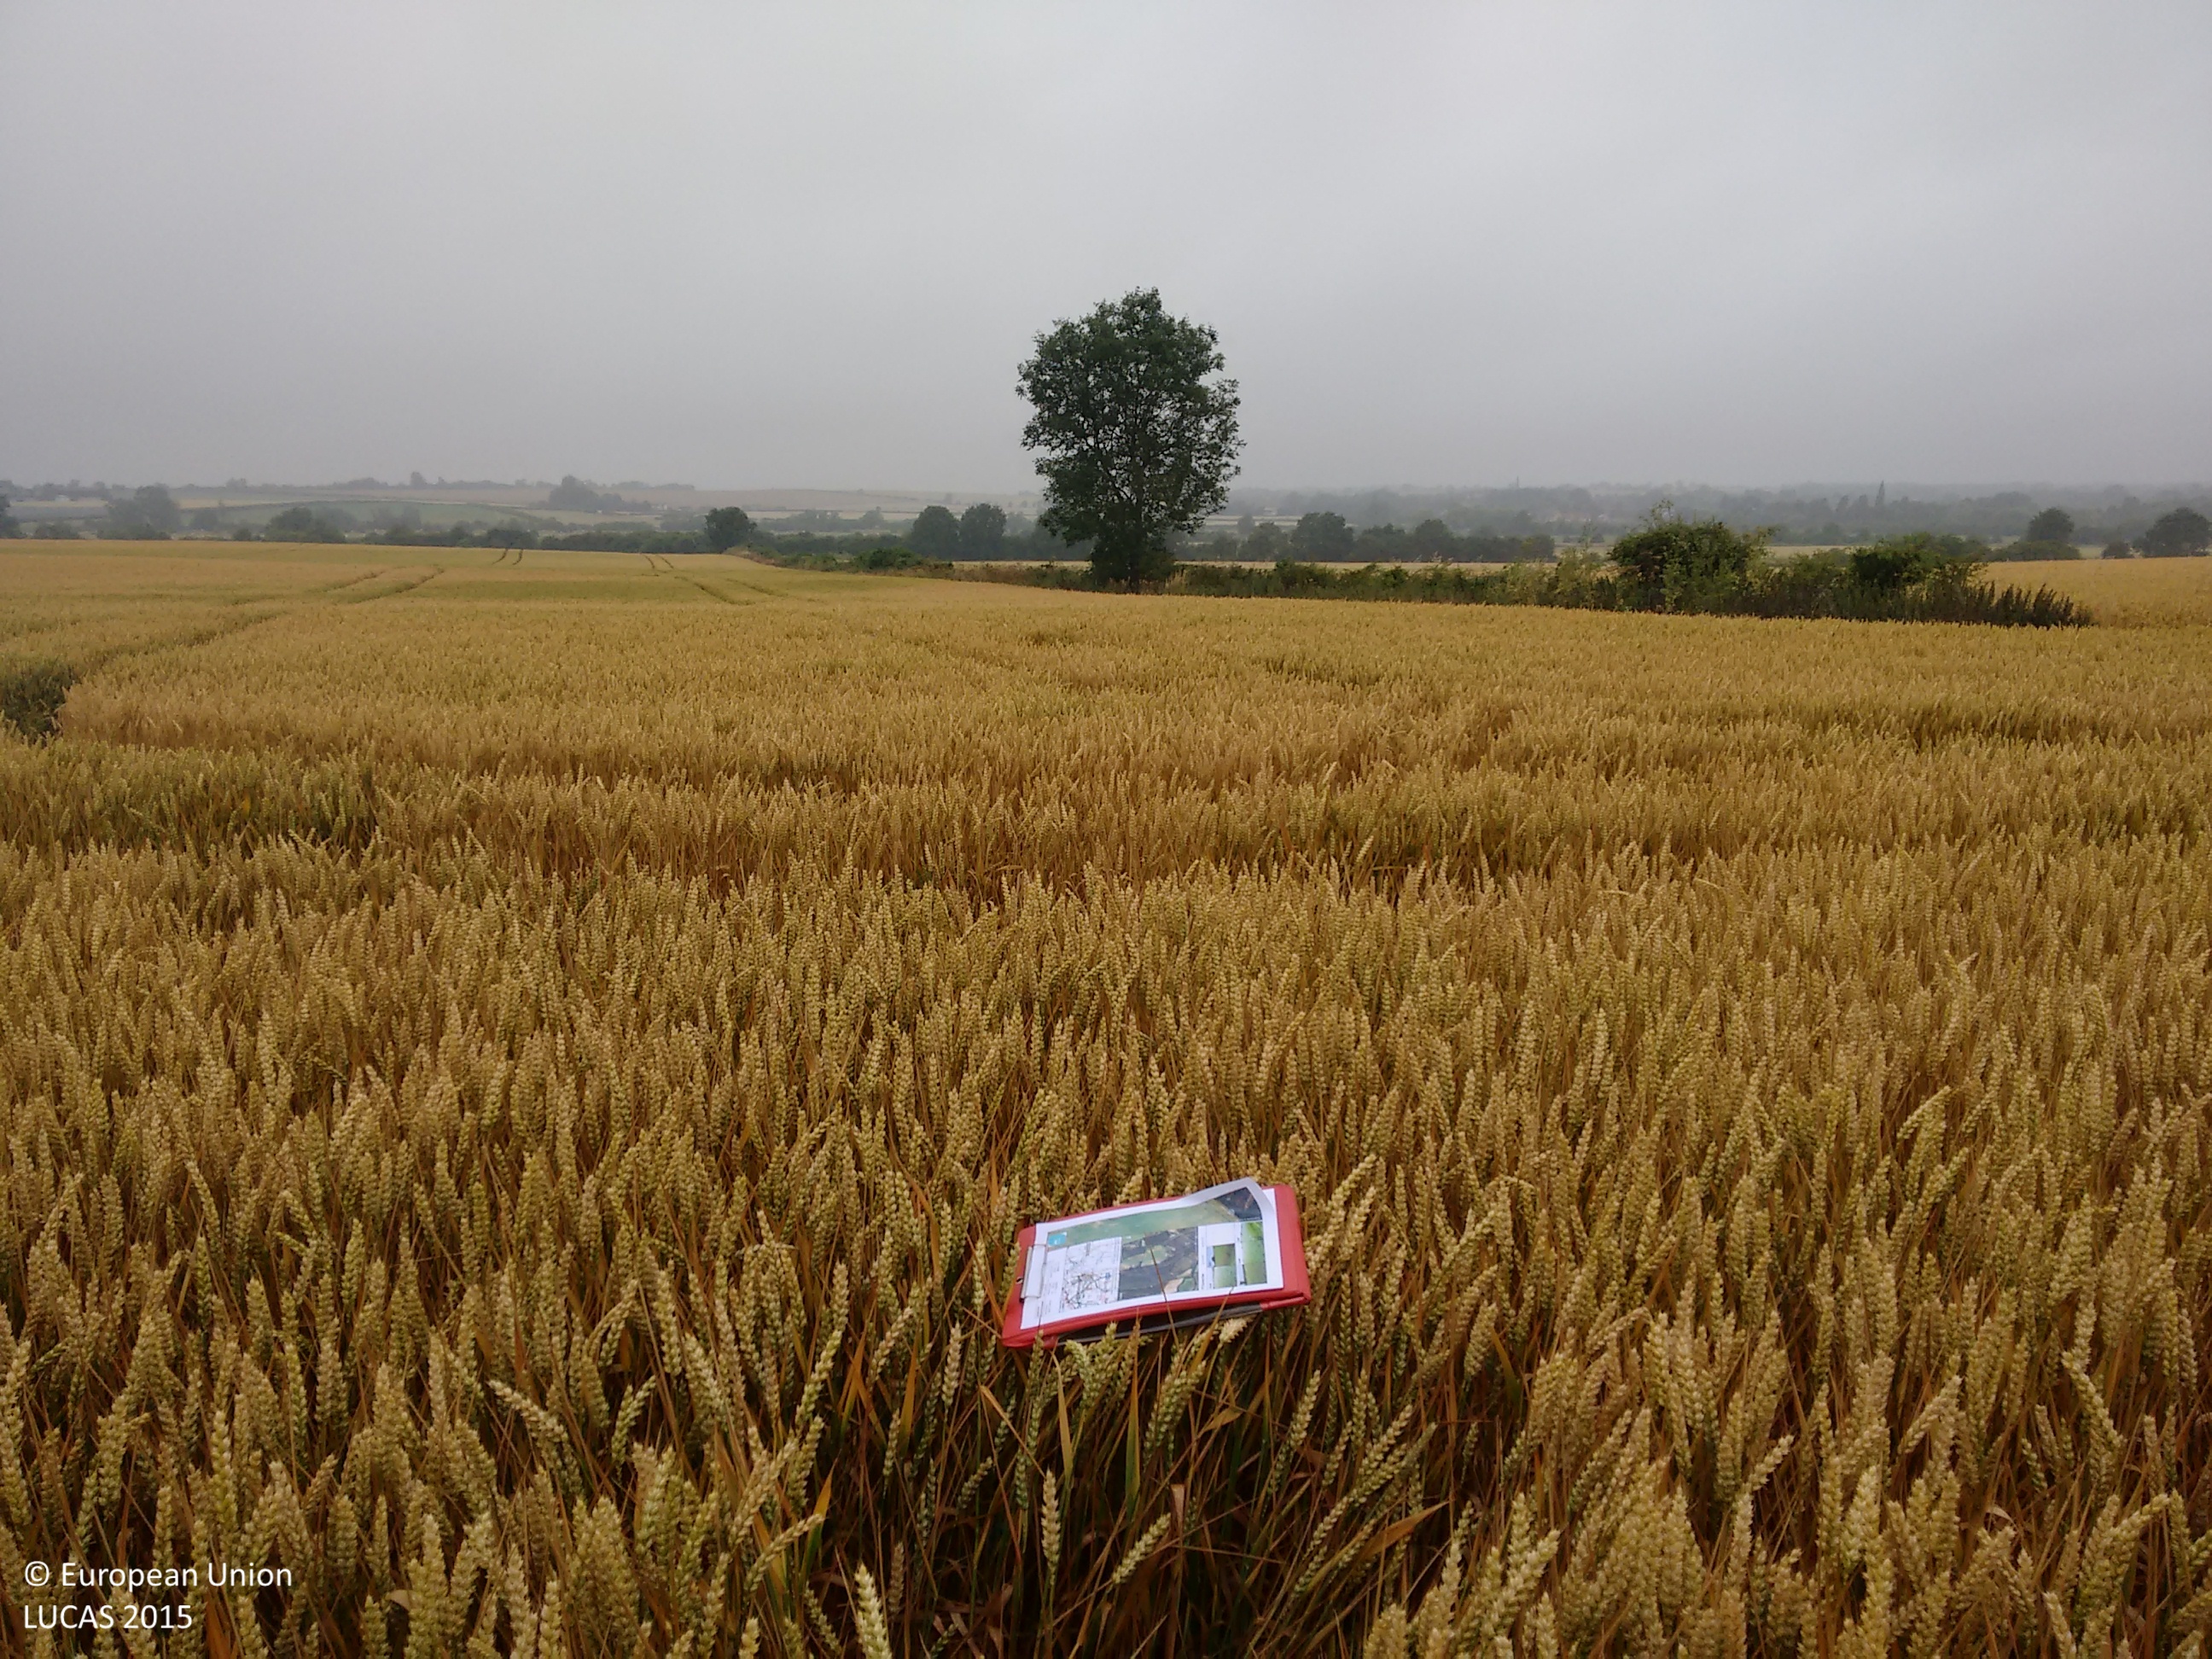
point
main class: Cropland
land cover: Common wheat
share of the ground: > 75 %
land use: Agriculture (excluding fallow land and kitchen gardens)
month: July
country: GB
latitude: 52.5535
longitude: -0.4053
